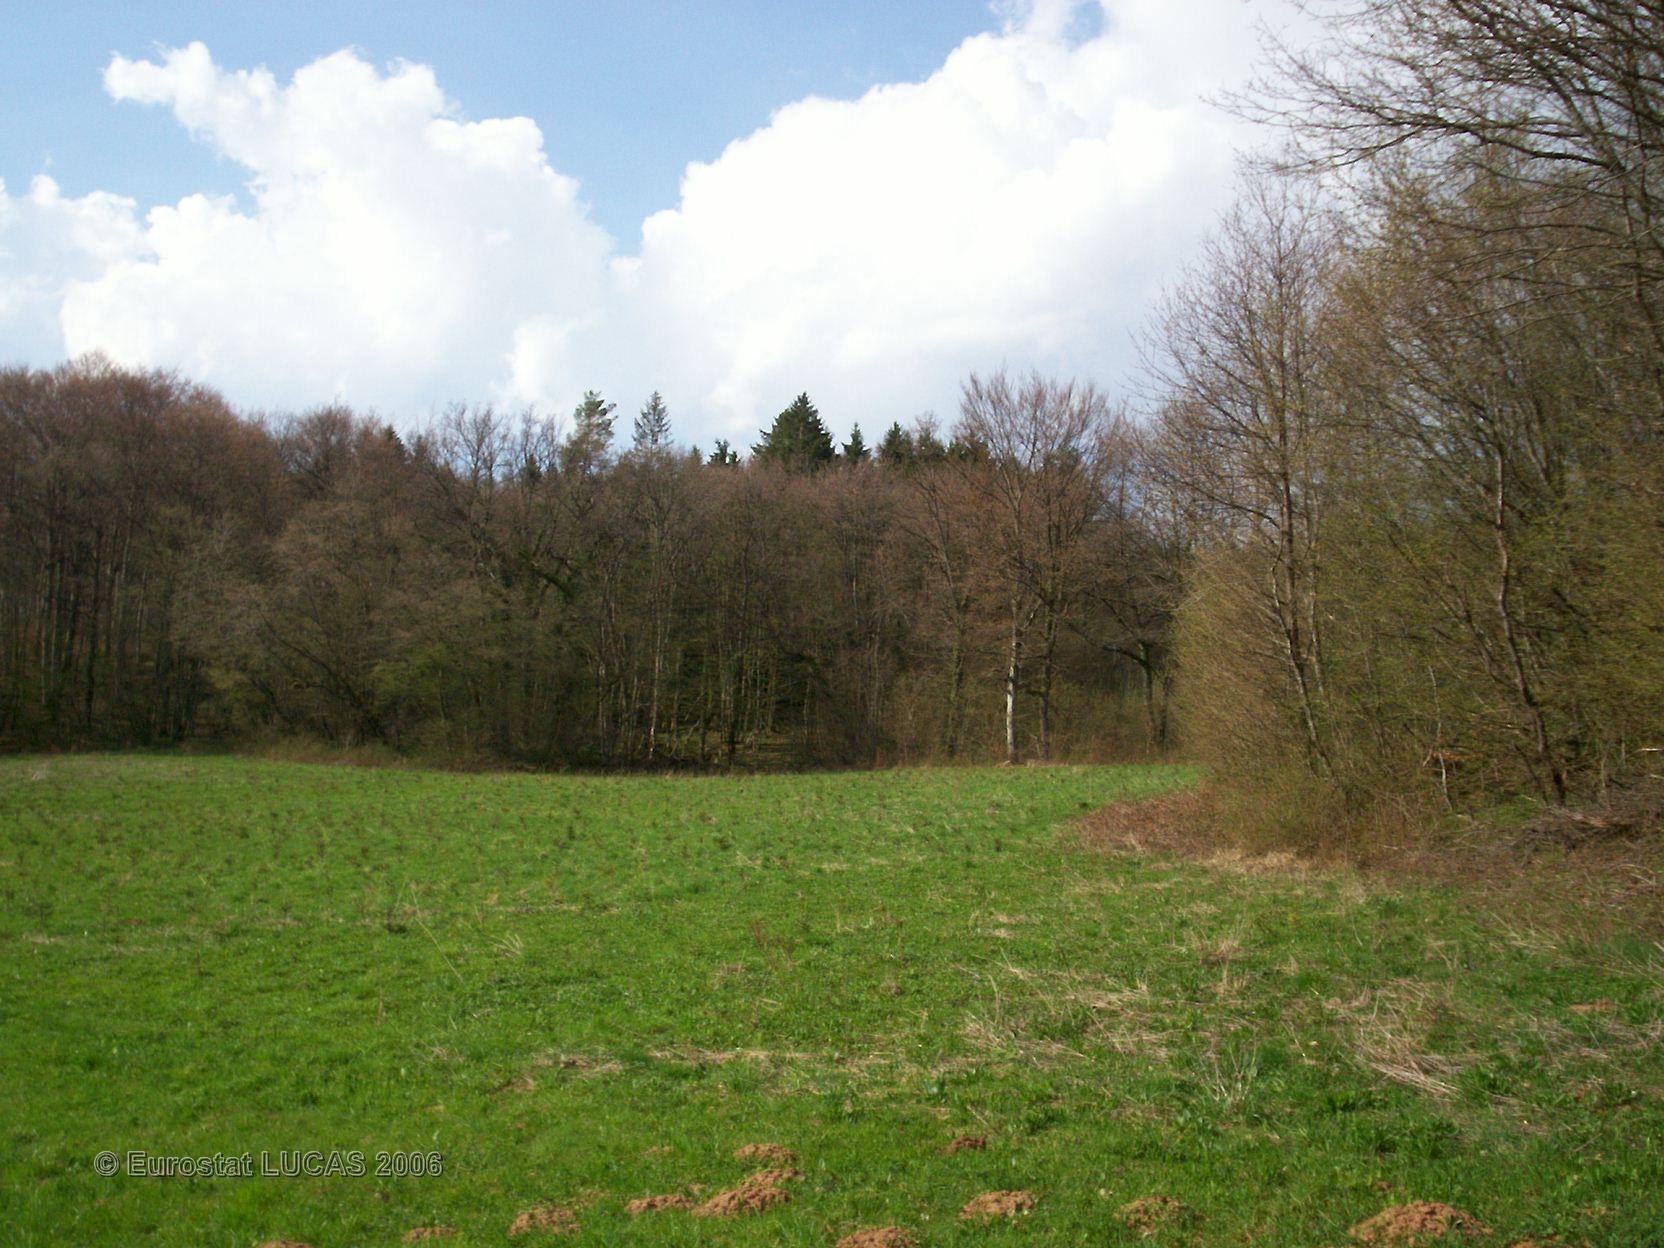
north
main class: Grassland
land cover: Grassland without tree/shrub cover
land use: Agriculture (excluding fallow land and kitchen gardens)
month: April
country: FR
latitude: 47.2809
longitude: 6.3662
